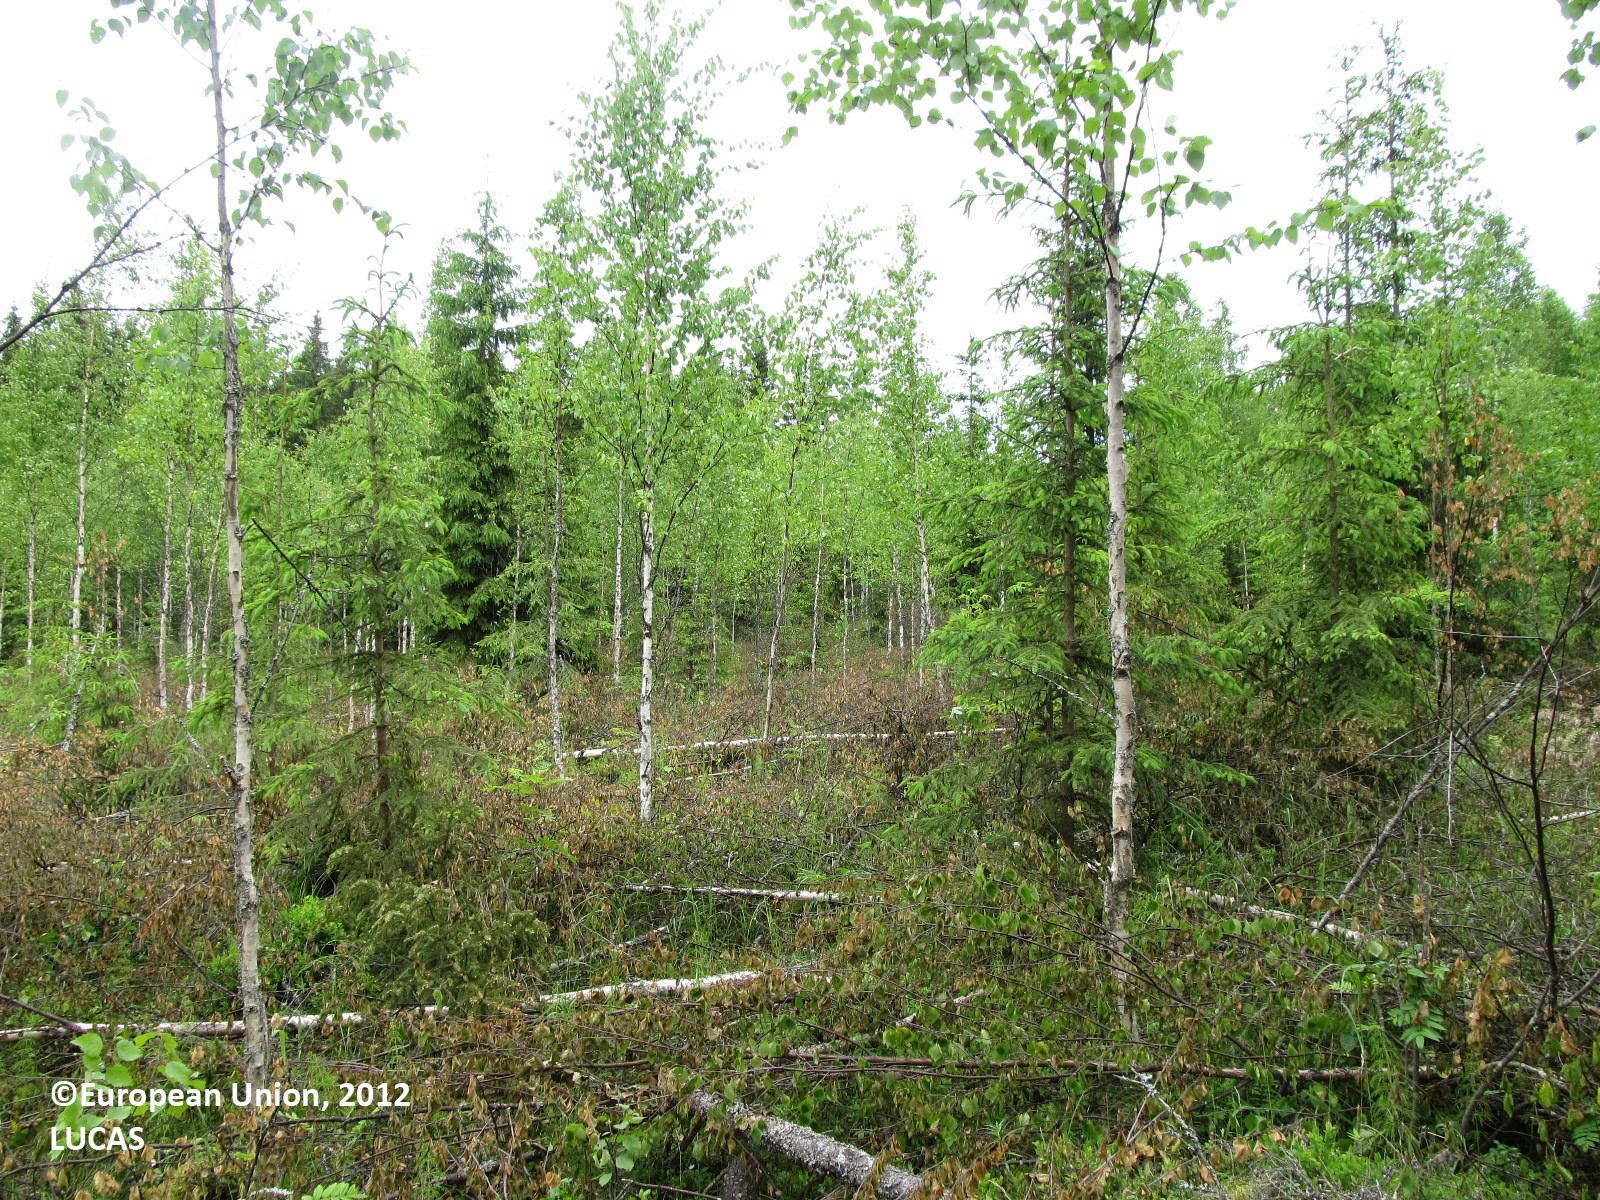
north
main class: Woodland
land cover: Spruce dominated mixed woodland
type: boreal forest
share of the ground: 10 - 25 %
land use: Forestry
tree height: < 5 m
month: June
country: FI
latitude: 63.1878
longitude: 27.8360
